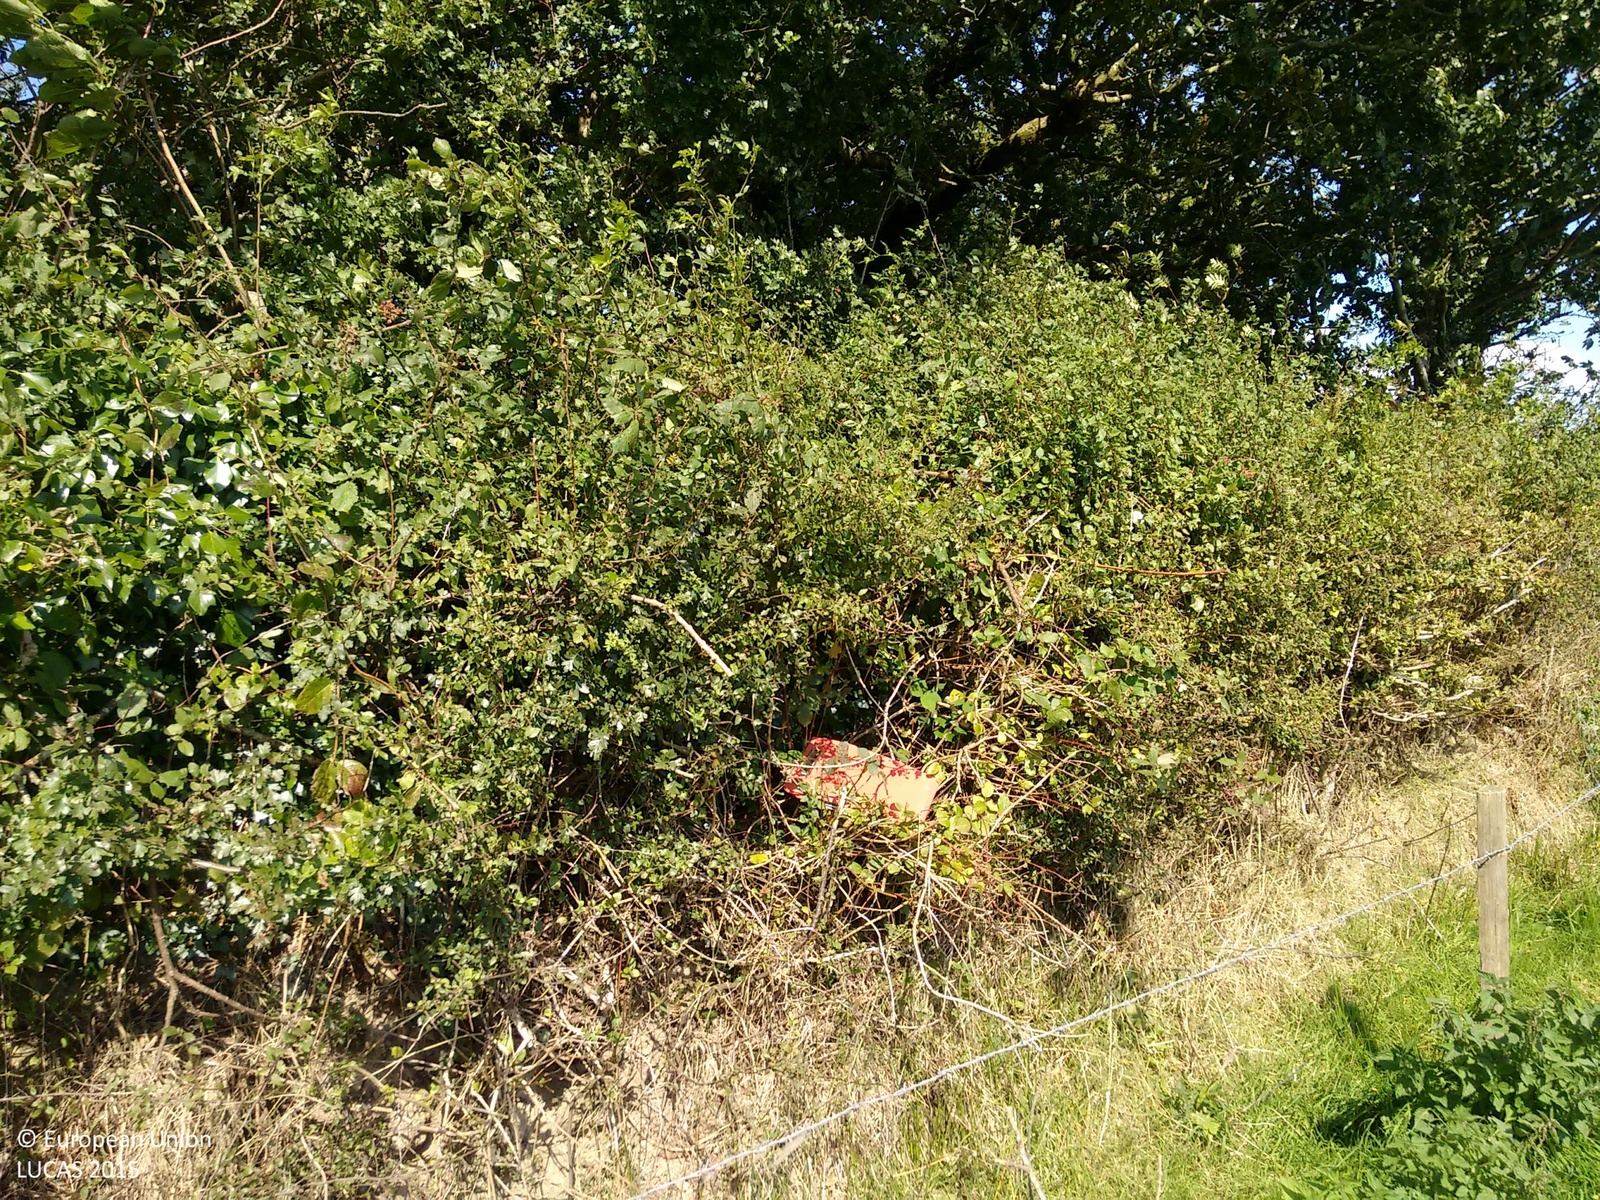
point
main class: Woodland
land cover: Broadleaved woodland
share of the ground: > 75 %
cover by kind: broadleaved forest trees 100 %
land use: Agriculture (excluding fallow land and kitchen gardens)
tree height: > 5 m
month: September
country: GB
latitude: 50.8593
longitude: -4.0605
